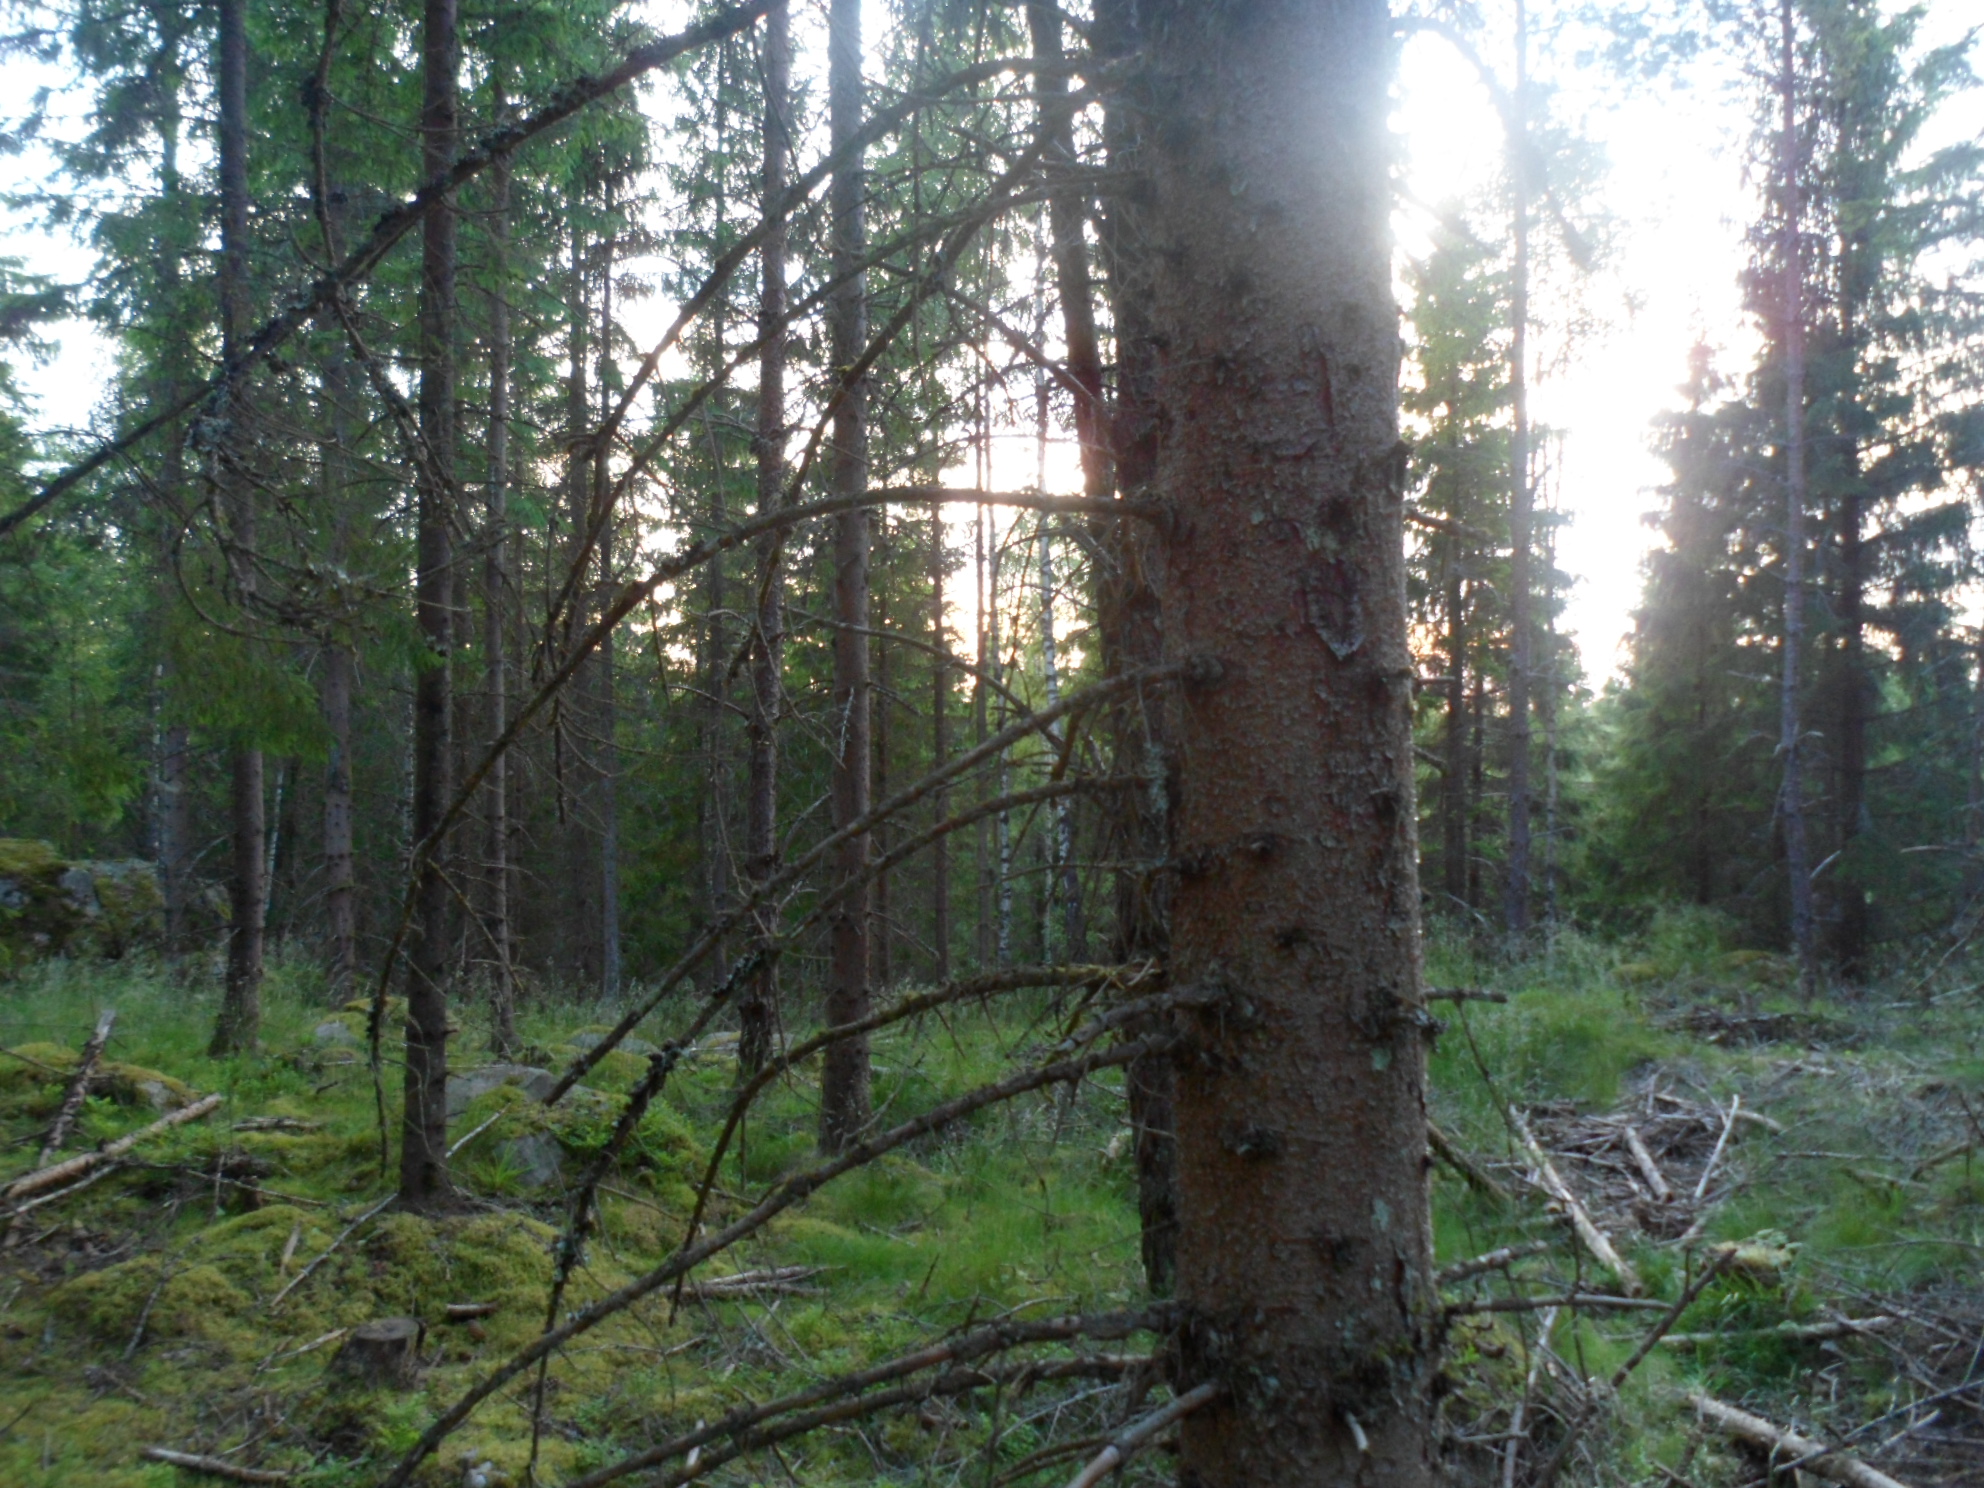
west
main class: Woodland
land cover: Spruce dominated coniferous woodland
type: boreal forest
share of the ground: 50 - 75 %
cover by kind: coniferous forest trees 55 %, herbaceous plants 15 %, broadleaved forest trees 10 %, shrubs 10 %, lichens and mosses 10 %
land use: Forestry
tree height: > 5 m
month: July
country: SE
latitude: 57.2103
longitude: 14.4167
